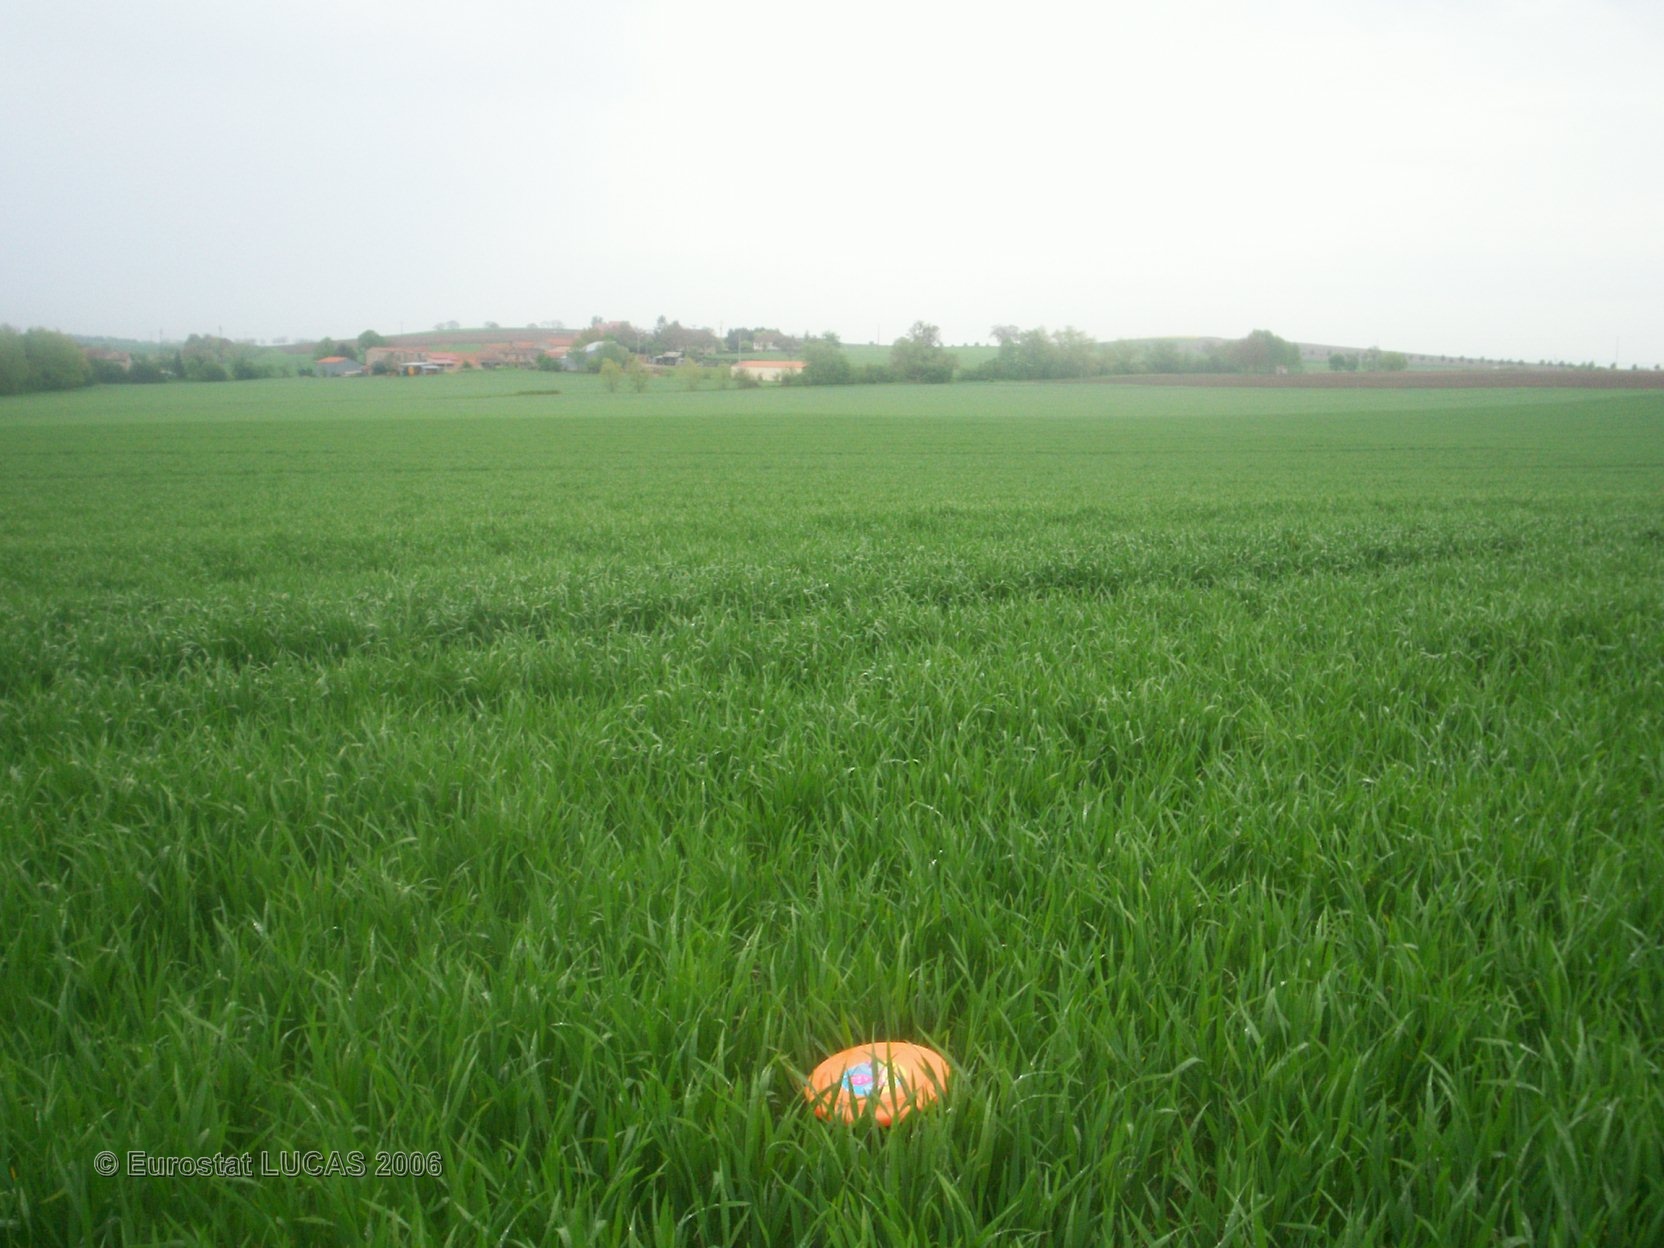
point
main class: Cropland
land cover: Rye
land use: Agriculture (excluding fallow land and kitchen gardens)
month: May
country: FR
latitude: 45.9882
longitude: 3.1701
